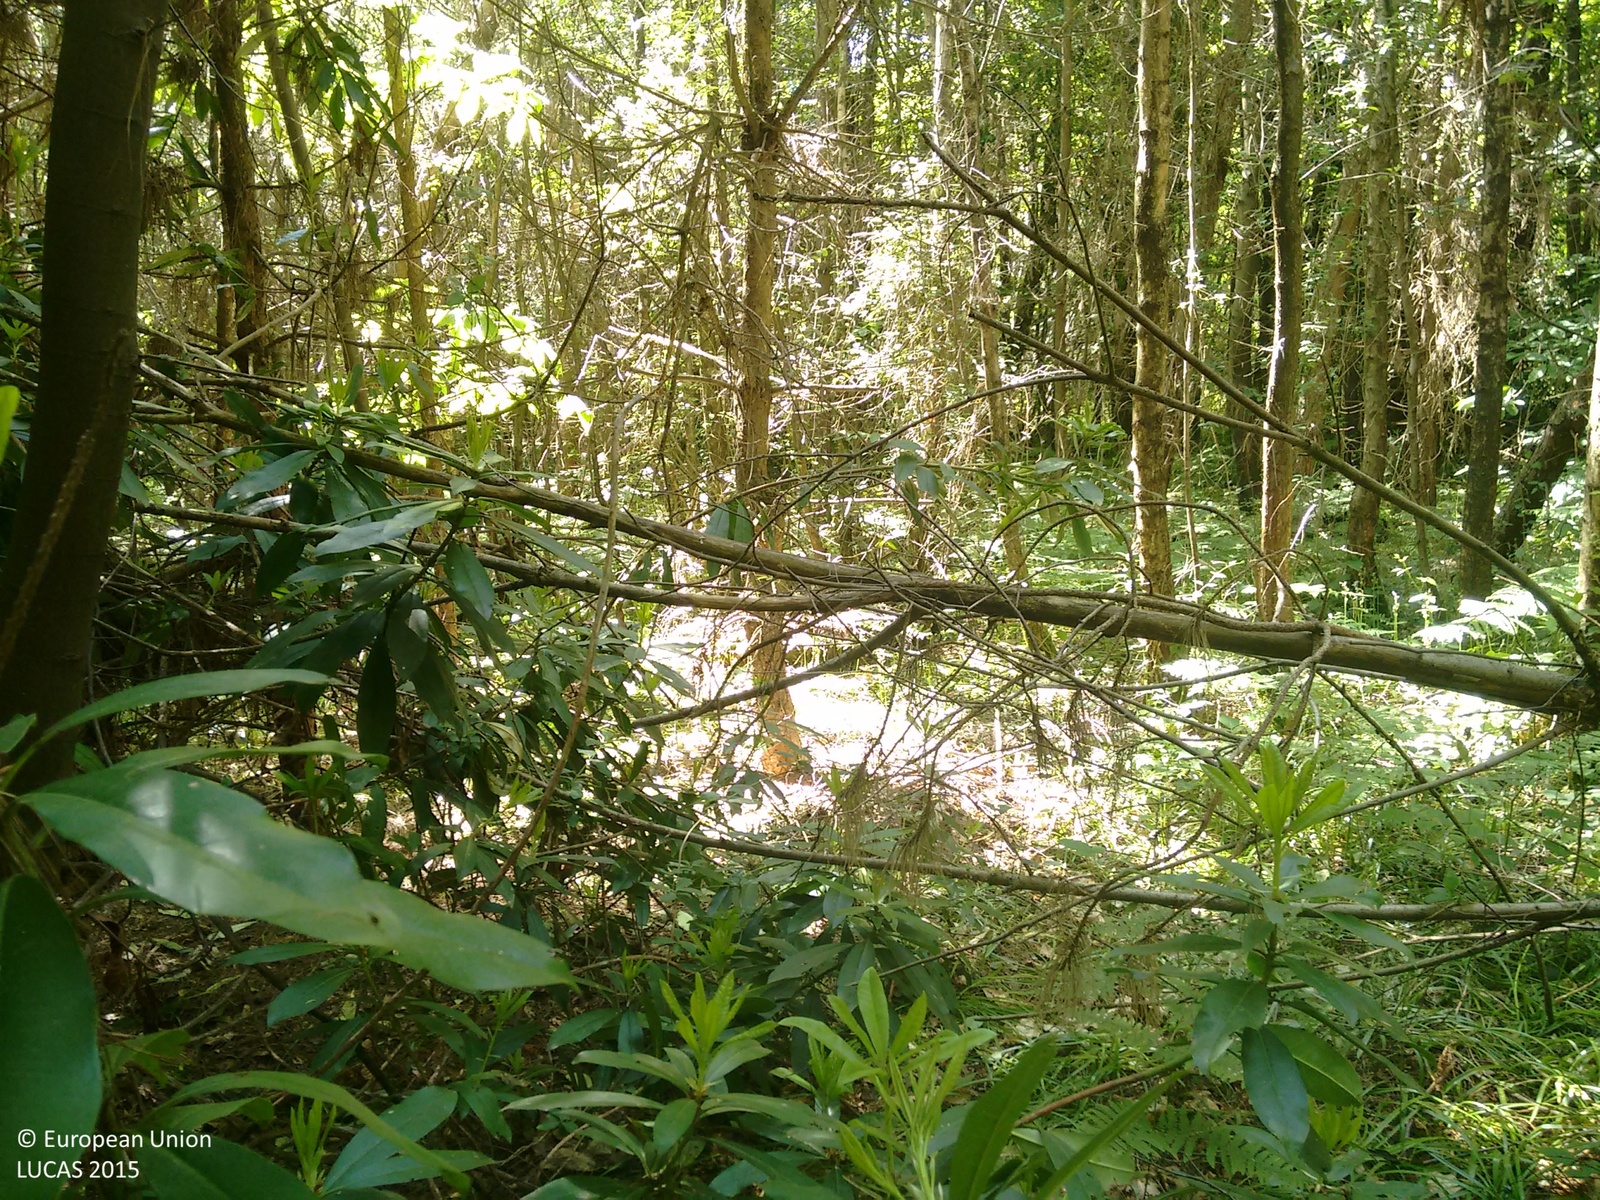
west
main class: Woodland
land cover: Other mixed woodland
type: exotic forest
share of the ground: > 75 %
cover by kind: coniferous forest trees 70 %, broadleaved forest trees 30 %
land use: Forestry
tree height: > 5 m
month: June
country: GB
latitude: 51.0708
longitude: 0.4814
